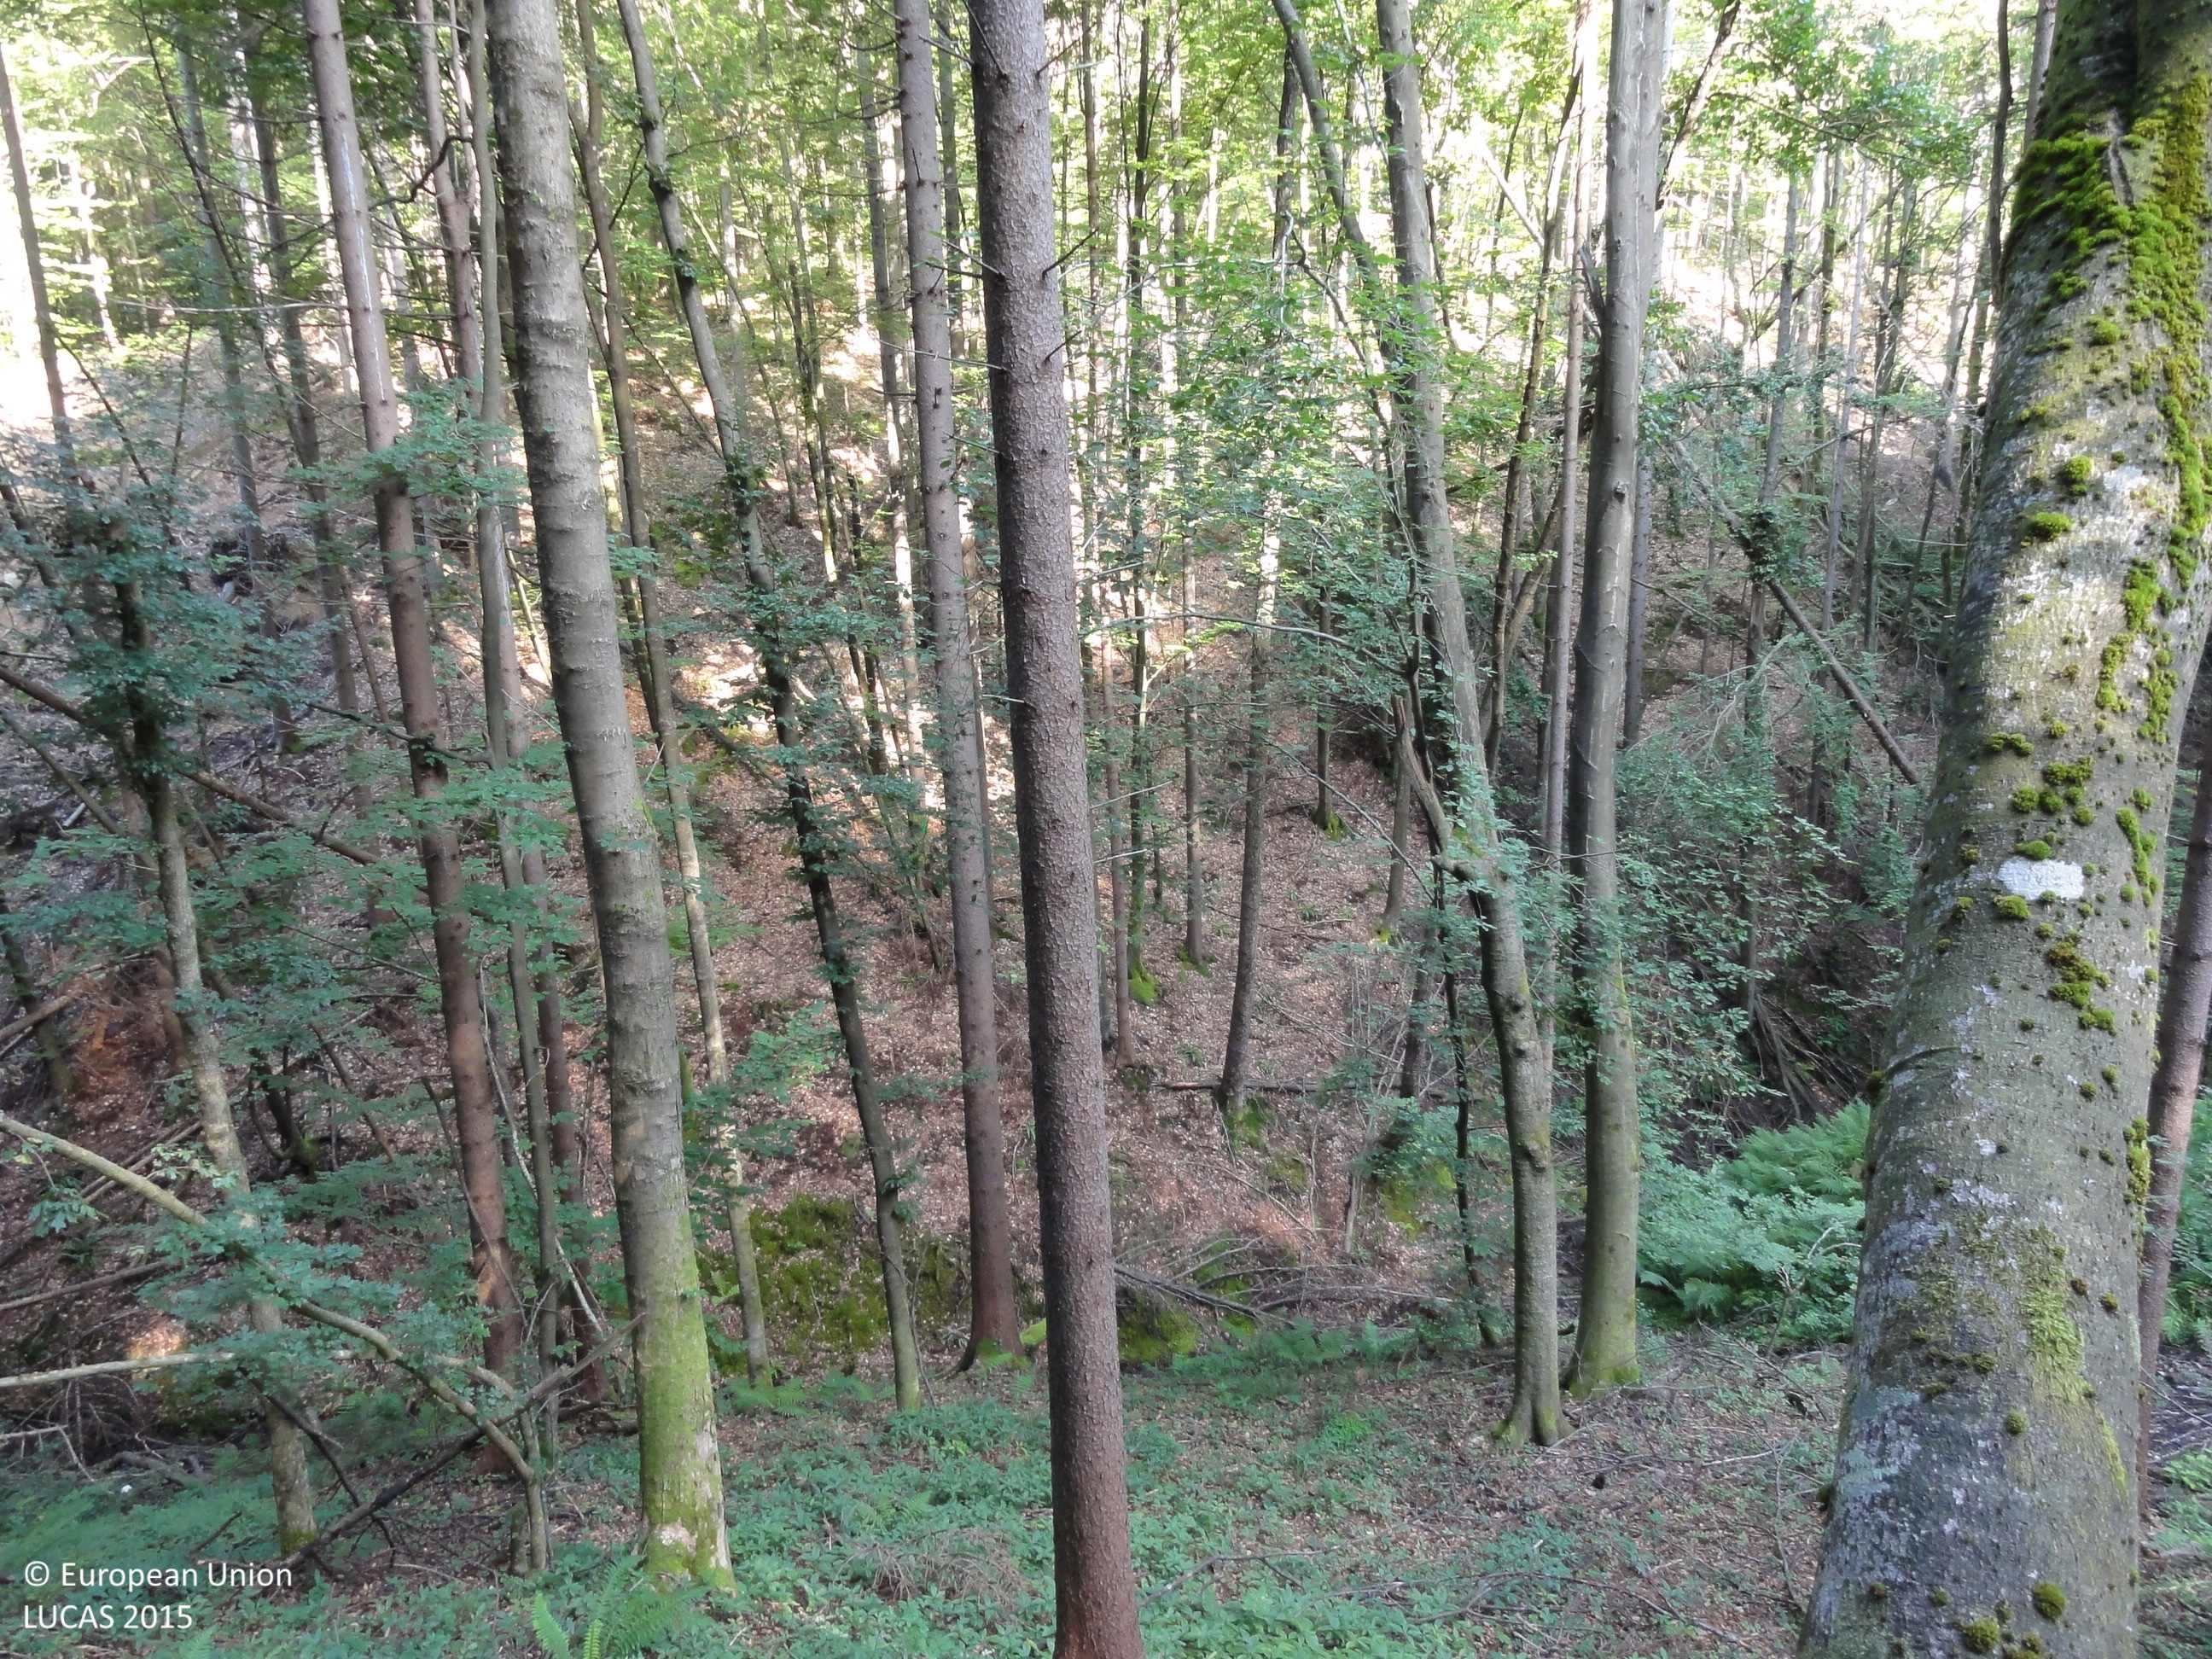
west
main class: Woodland
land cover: Spruce dominated mixed woodland
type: mountainous beech forest
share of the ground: > 75 %
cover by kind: broadleaved forest trees 50 %, coniferous forest trees 25 %, herbaceous plants 20 %, shrubs 5 %
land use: Forestry
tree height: > 5 m
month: August
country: SI
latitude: 46.3173
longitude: 15.1535
